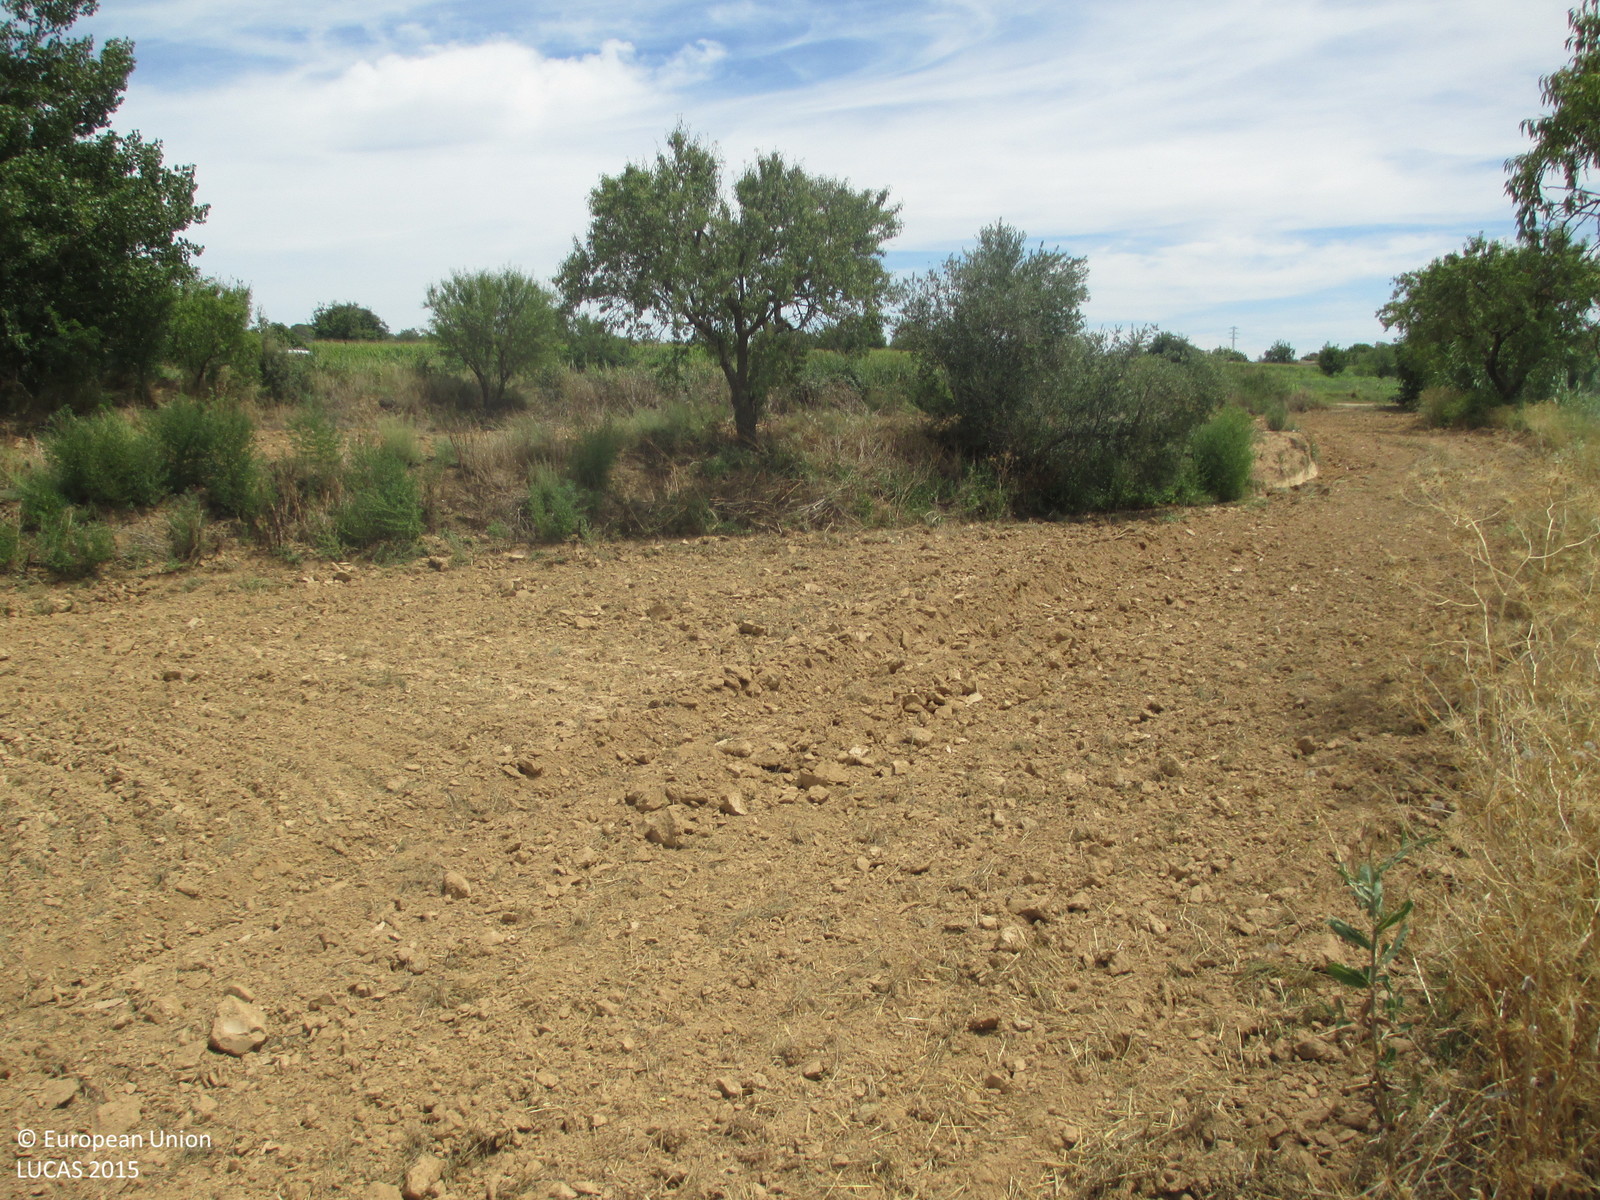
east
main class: Cropland
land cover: Maize
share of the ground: > 75 %
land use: Agriculture (excluding fallow land and kitchen gardens)
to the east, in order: Maize; Electric lines; Maize; Shruby margins; Single bushes/trees; Other bare soil; Shruby margins; Single bushes/trees; Other bare soil; Shruby margins; Tracks; Shruby margins; Lucerne; Shruby margins; Single bushes/trees; Maize; Shruby margins; Maize
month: July
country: ES
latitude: 41.8612
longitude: 0.3107
